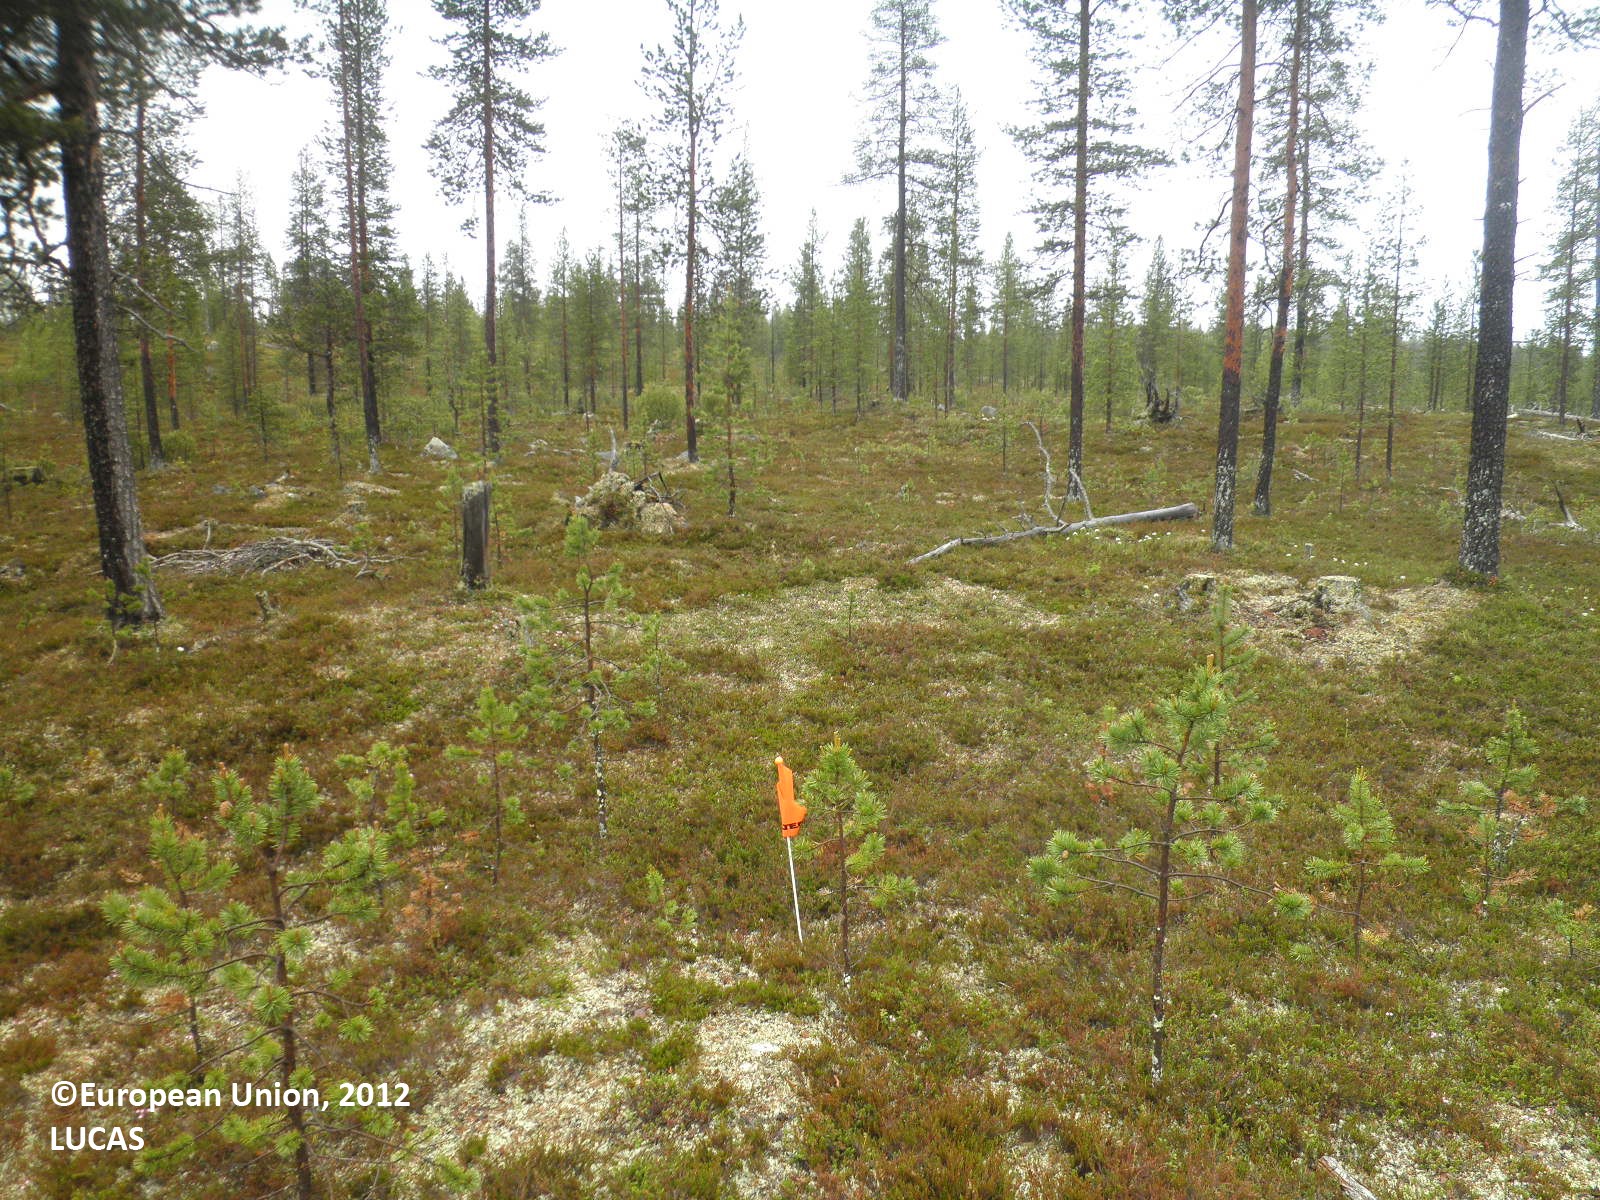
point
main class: Woodland
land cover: Pine dominated coniferous woodland
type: boreal forest
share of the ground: 25 - 50 %
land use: Forestry
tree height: > 5 m
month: June
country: FI
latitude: 68.4806
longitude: 27.5982
